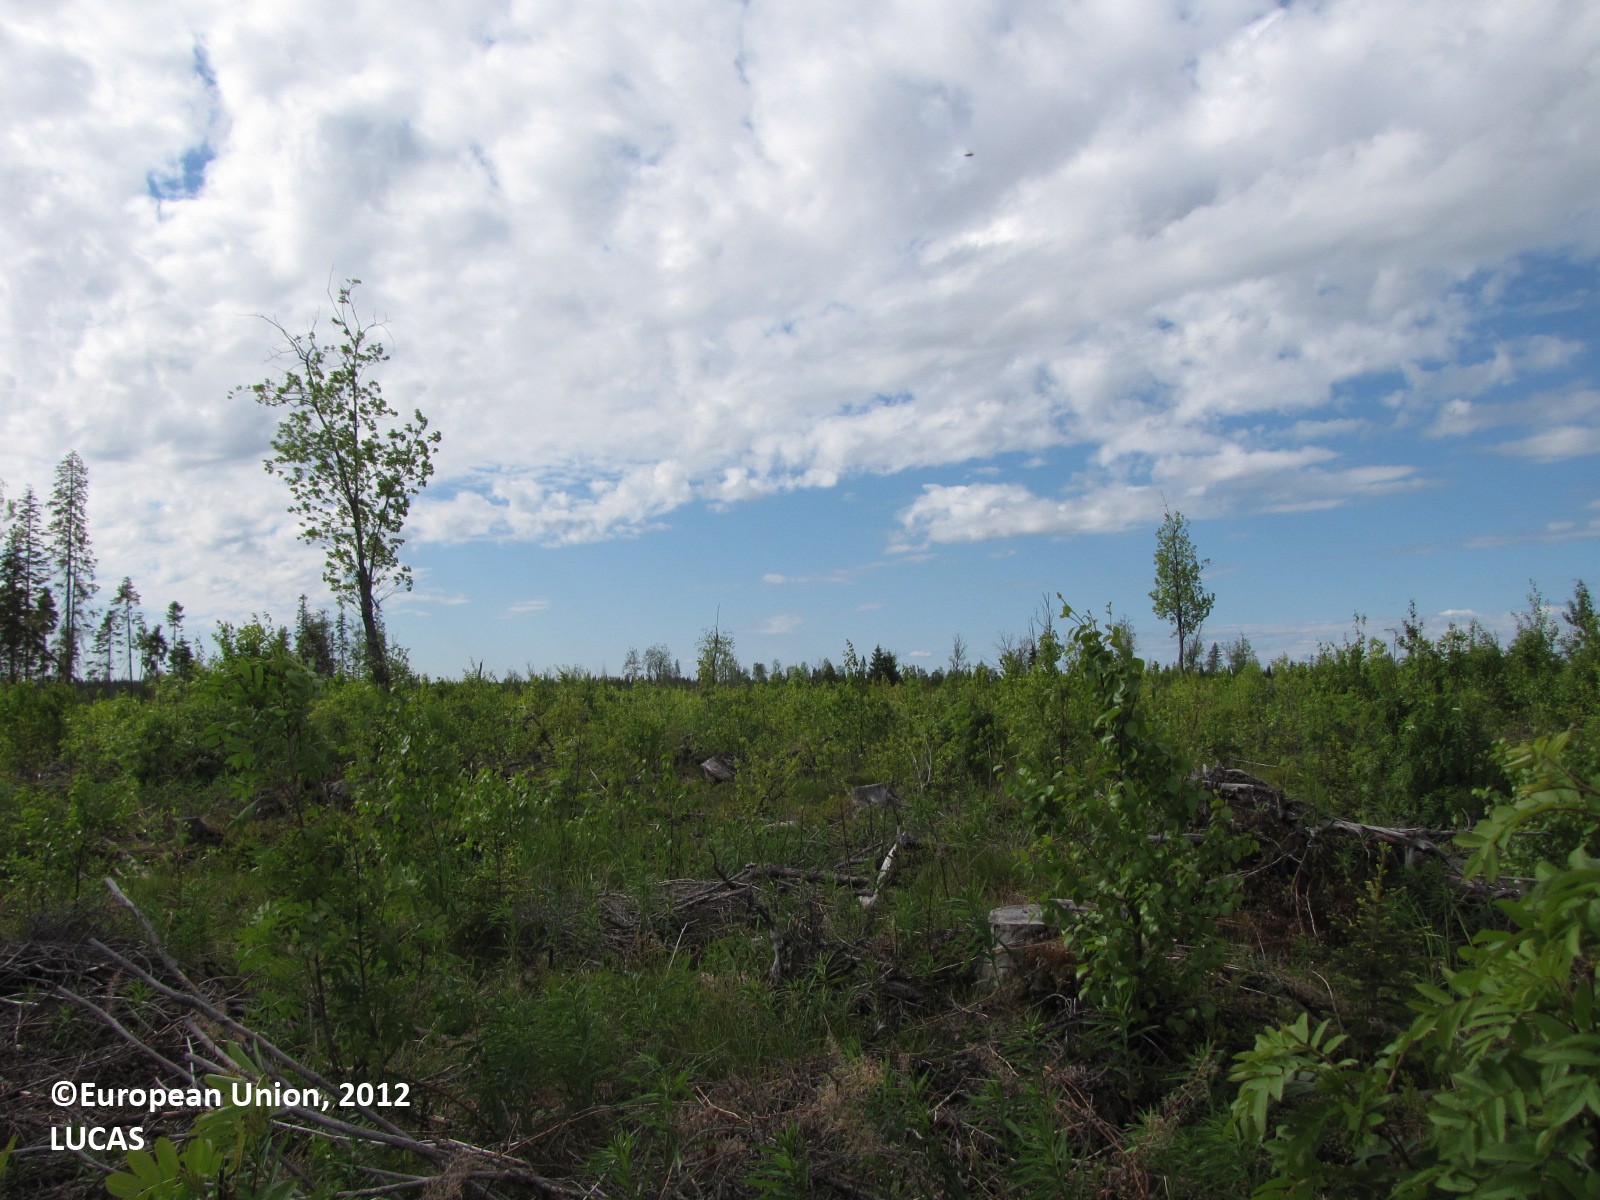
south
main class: Woodland
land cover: Broadleaved woodland
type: boreal forest
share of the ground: 25 - 50 %
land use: Forestry
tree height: < 5 m
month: June
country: FI
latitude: 66.0574
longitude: 24.6499
